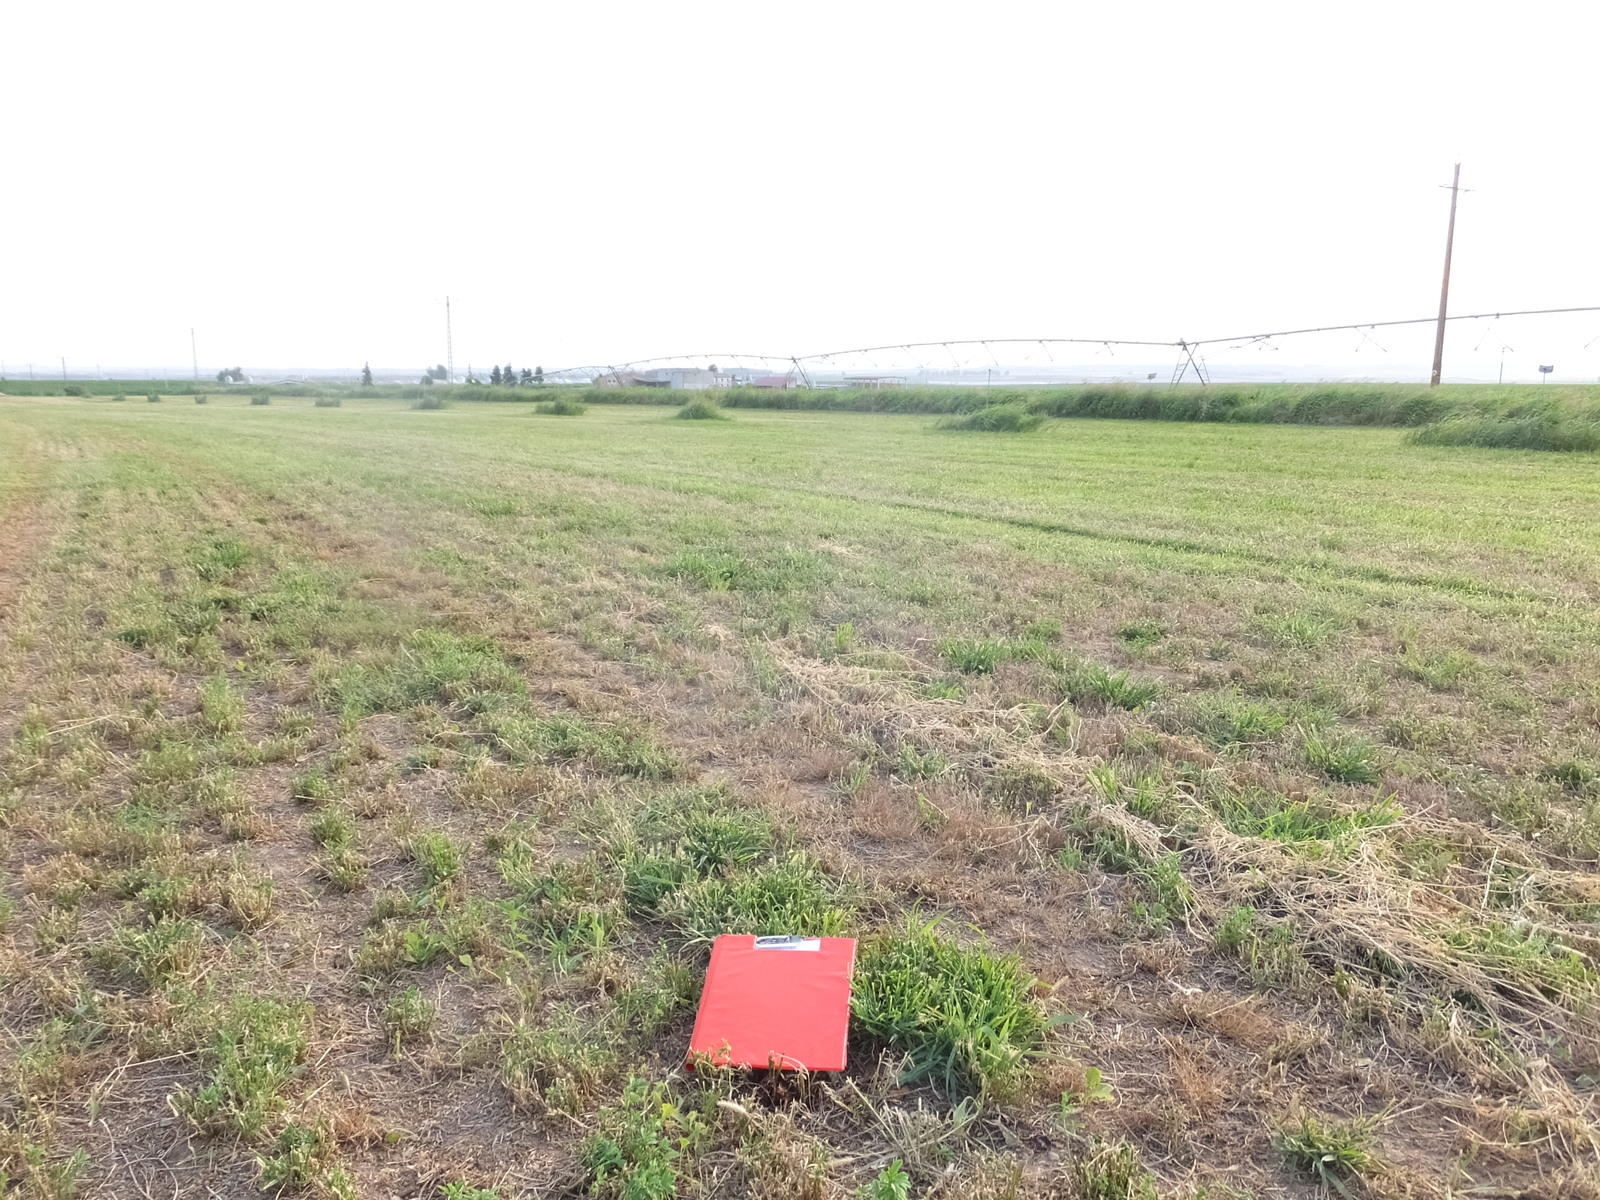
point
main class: Cropland
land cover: Lucerne
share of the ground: > 75 %
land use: Agriculture (excluding fallow land and kitchen gardens)
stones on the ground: < 10 %
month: July
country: ES
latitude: 41.7561
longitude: 0.3516
